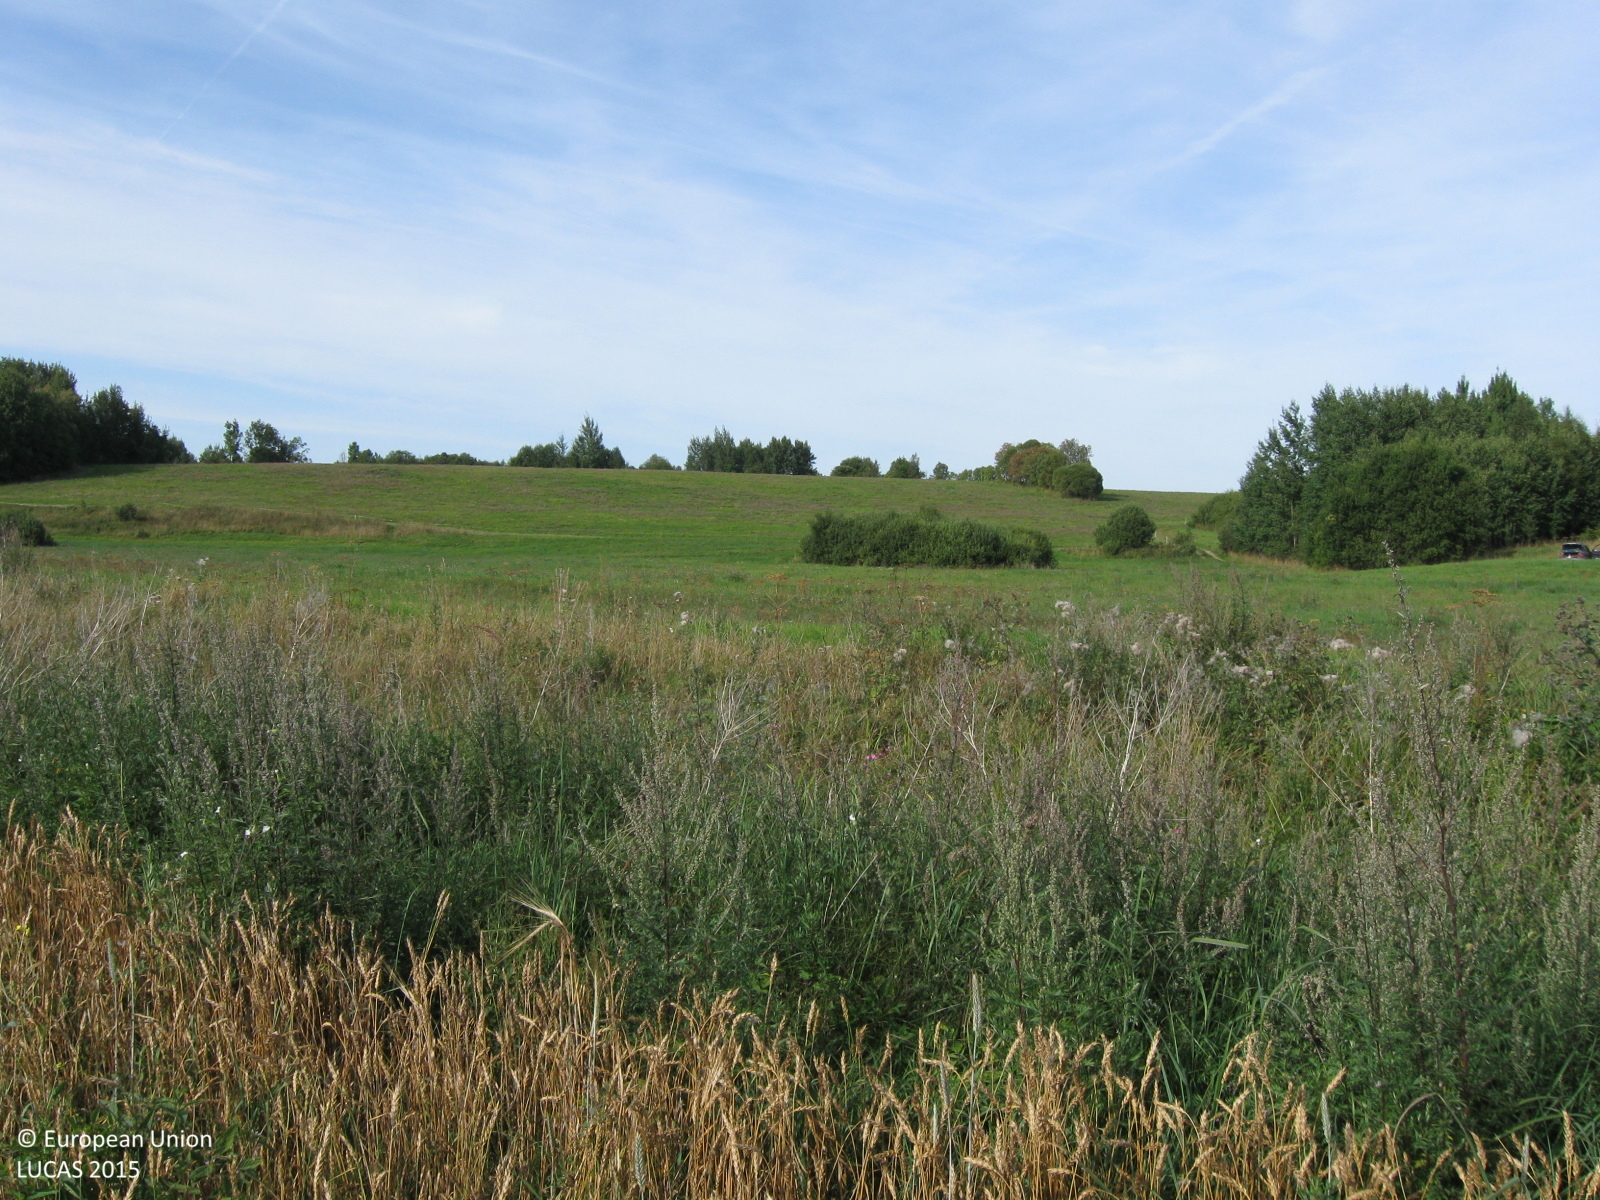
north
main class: Cropland
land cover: Common wheat
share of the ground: > 75 %
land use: Agriculture (excluding fallow land and kitchen gardens)
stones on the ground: < 10 %
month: August
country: LT
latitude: 55.4956
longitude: 22.5509
